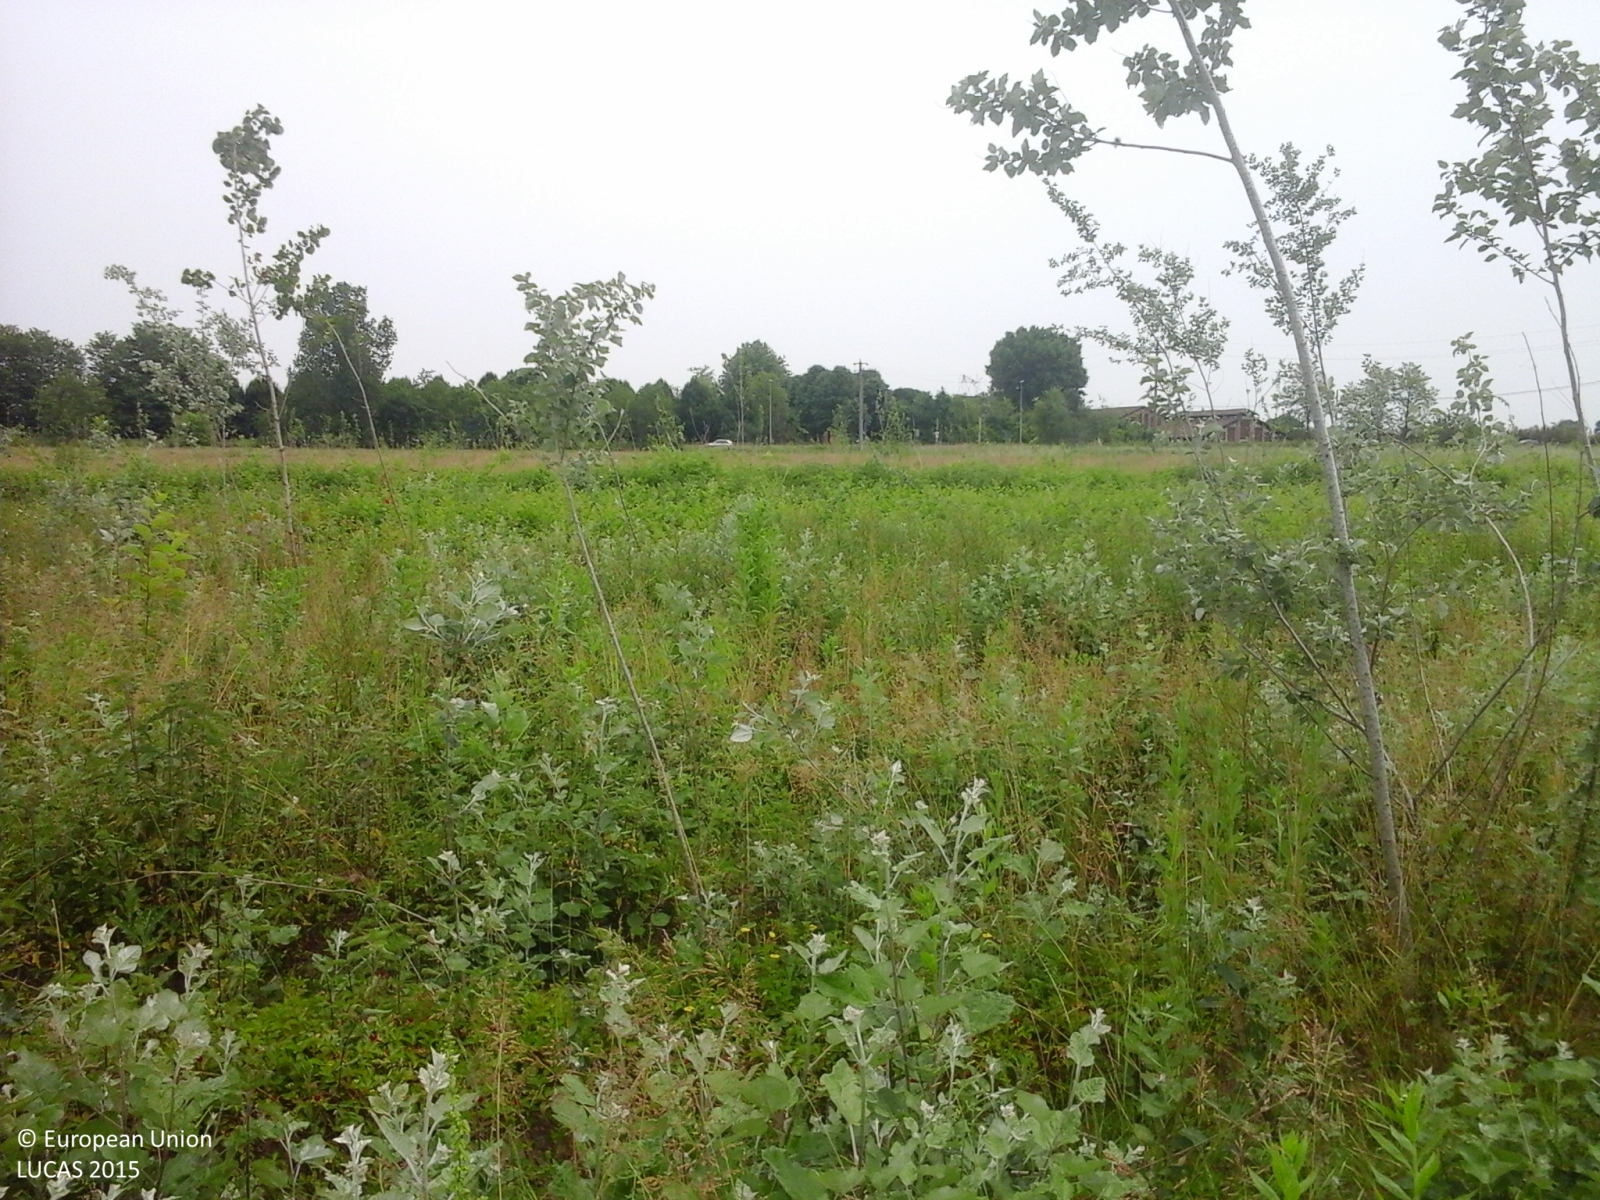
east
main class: Grassland
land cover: Grassland with sparse tree/shrub cover
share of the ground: > 75 %
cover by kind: herbaceous plants 90 %, broadleaved forest trees 5 %, shrubs 5 %
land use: Forestry
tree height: < 5 m
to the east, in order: Grassland with sparse tree/shrub cover; Grass margins; Ditches and canals; Grass margins; Grassland with sparse tree/shrub cover; Grass margins; Tracks; Electric lines; Ditches and canals; Grass margins; Artificial constructions in urban areas
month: May
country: IT
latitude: 45.2863
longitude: 9.3764
